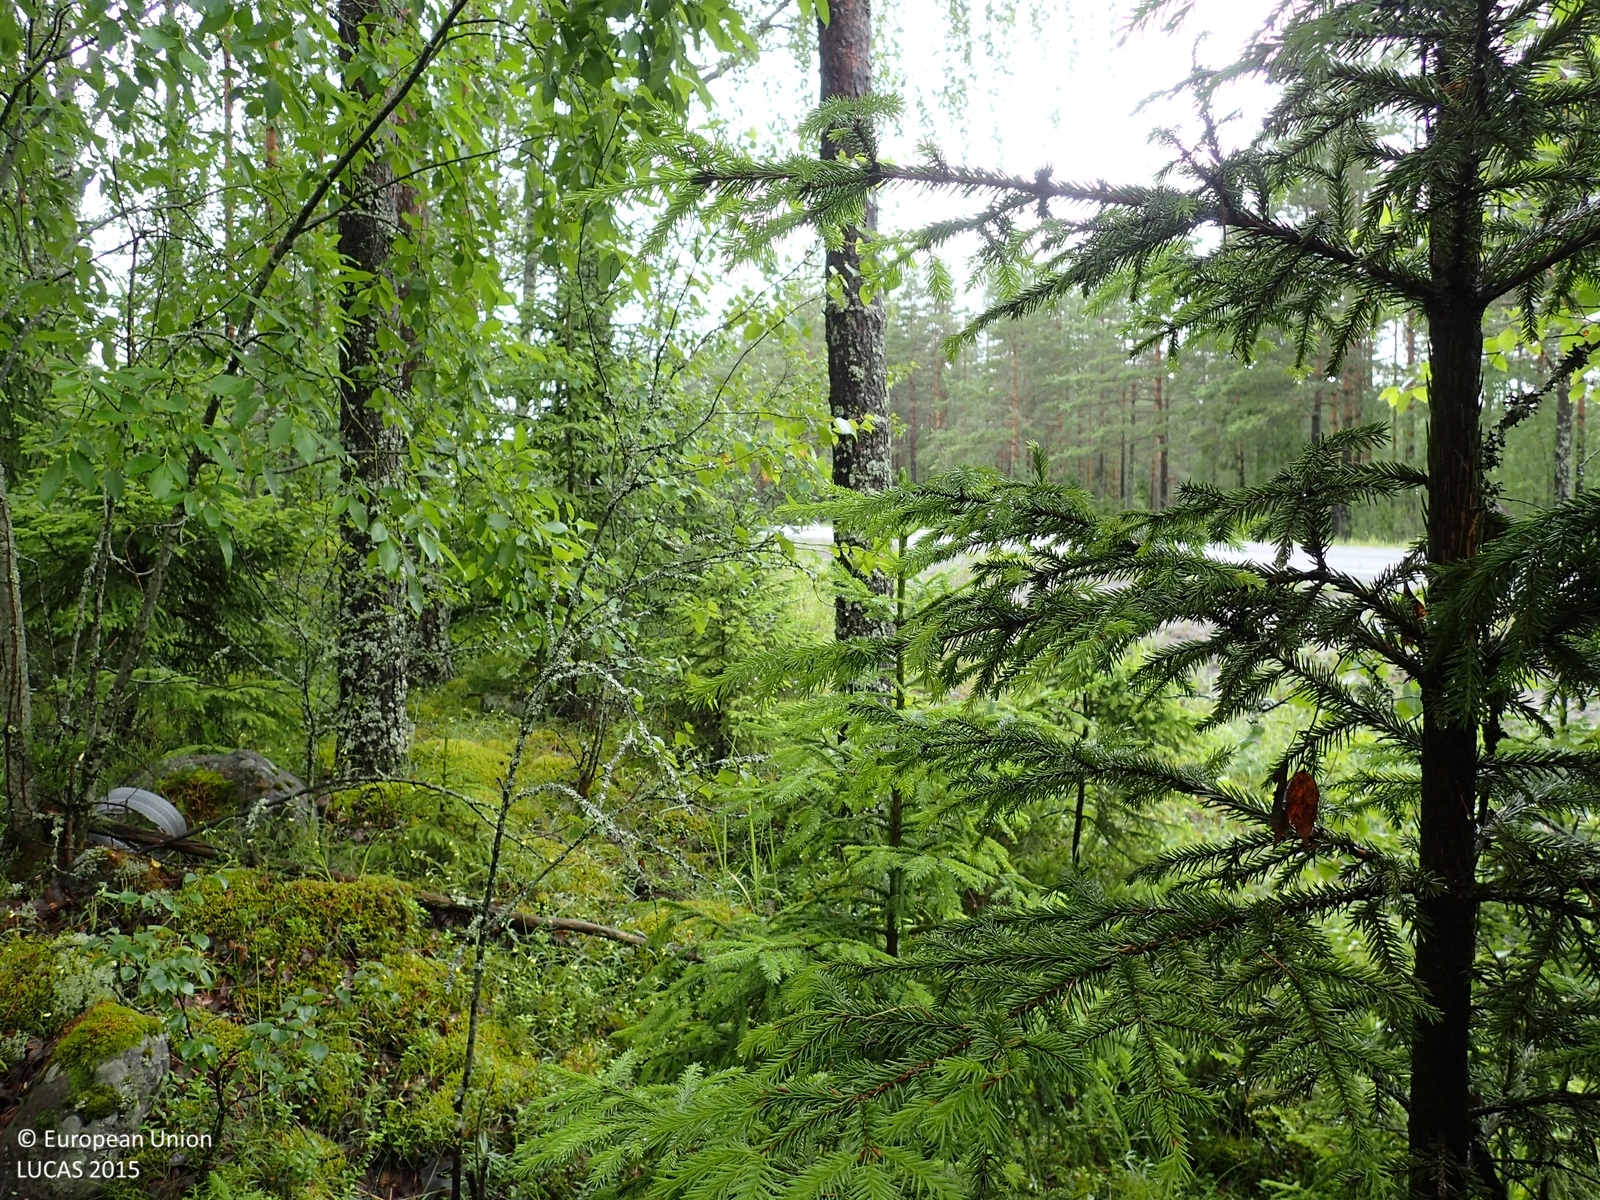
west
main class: Woodland
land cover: Pine dominated mixed woodland
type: boreal forest
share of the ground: 50 - 75 %
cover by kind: broadleaved forest trees 40 %, coniferous forest trees 20 %, shrubs 20 %, herbaceous plants 10 %, lichens and mosses 10 %
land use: Forestry
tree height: > 5 m
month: July
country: FI
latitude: 62.9826
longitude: 21.6236
